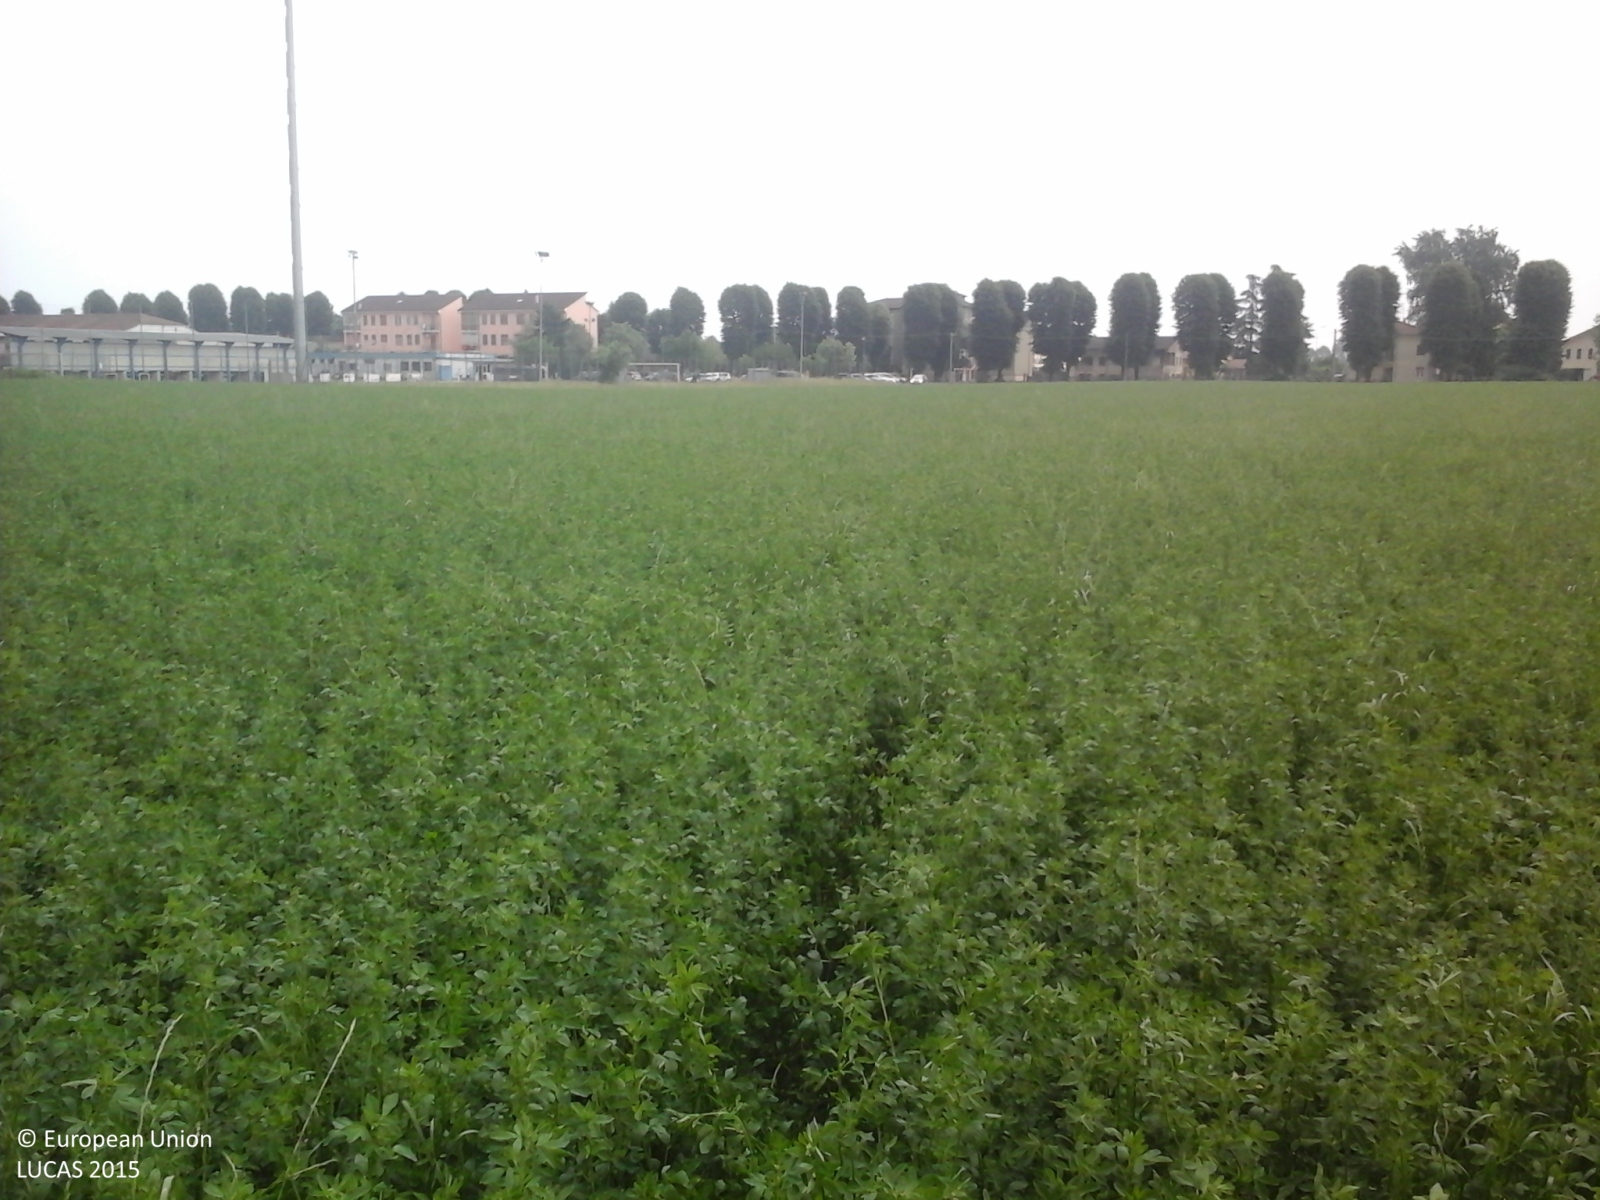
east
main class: Cropland
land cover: Lucerne
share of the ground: > 75 %
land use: Agriculture (excluding fallow land and kitchen gardens)
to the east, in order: Lucerne; Grass margins; Fences; Grassland without tree/shrub cover; Fences; Managed hedges; Artificial constructions in urban areas
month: May
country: IT
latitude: 45.1962
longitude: 10.6226
